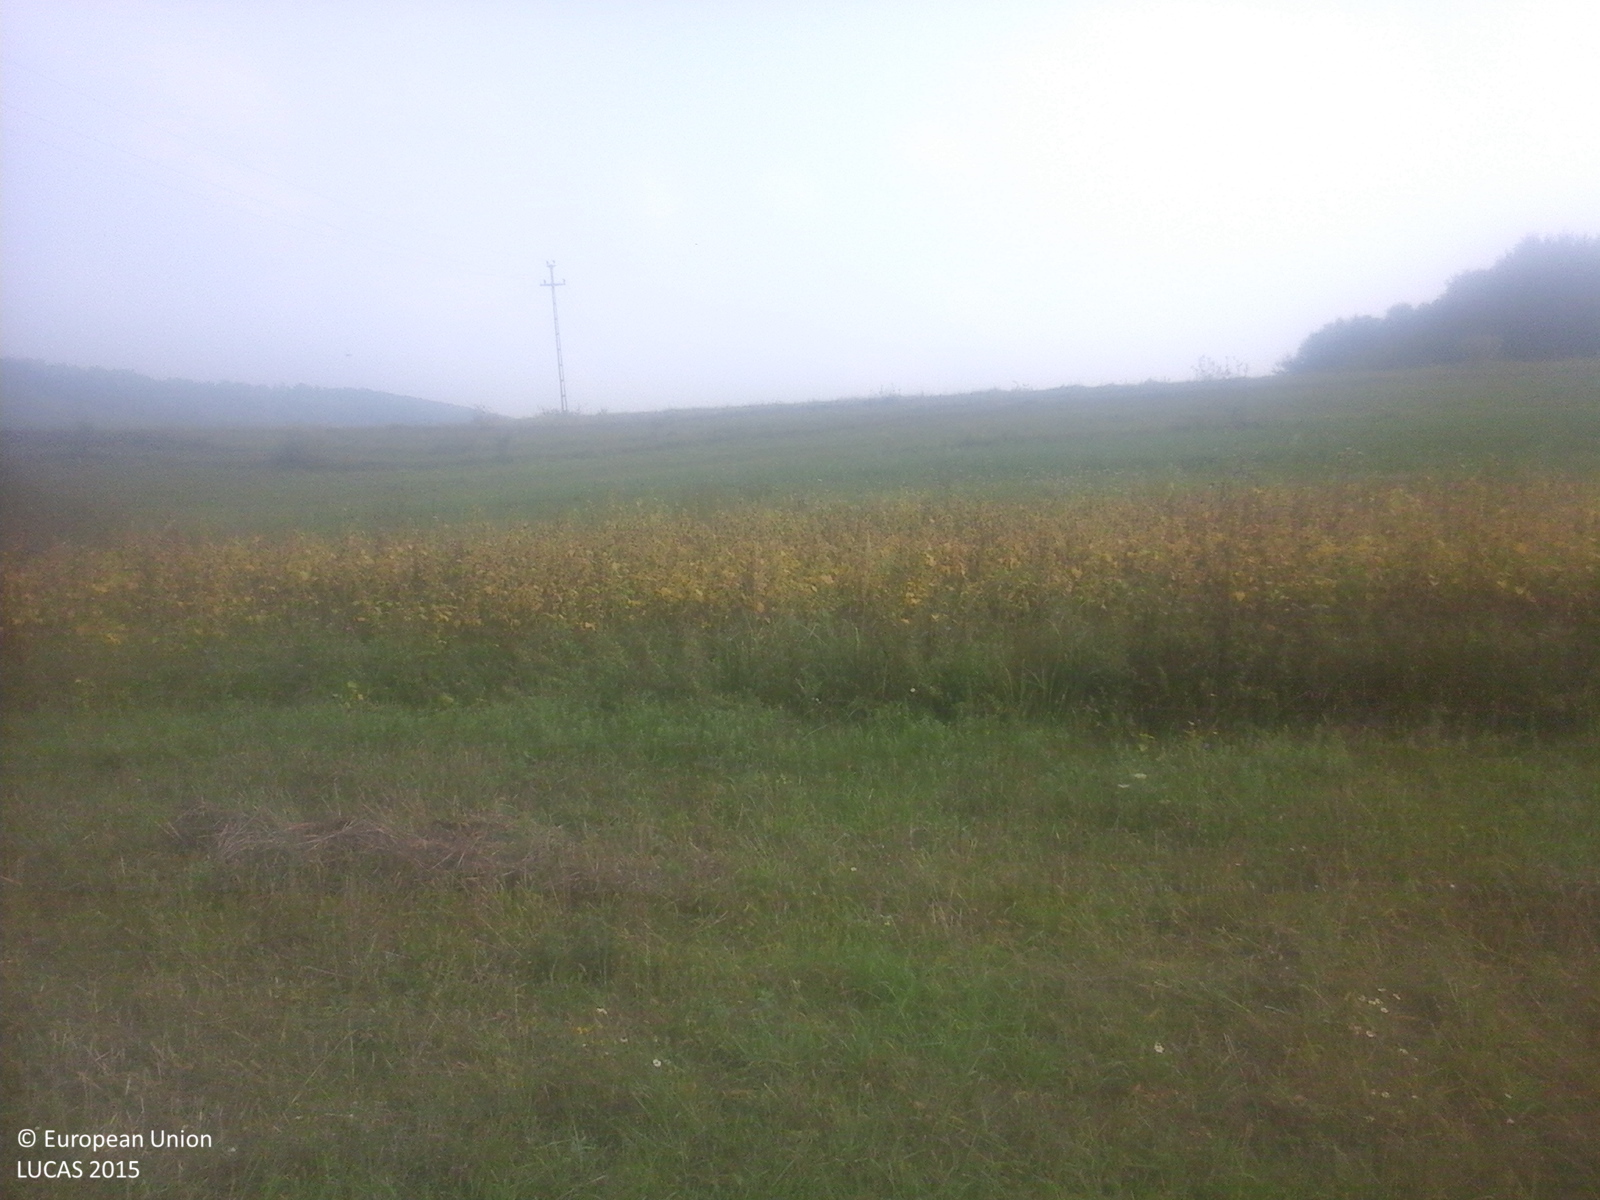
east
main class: Cropland
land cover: Temporary grasslands
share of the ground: > 75 %
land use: Agriculture (excluding fallow land and kitchen gardens)
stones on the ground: < 10 %
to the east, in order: Temporary grasslands; Spontaneously vegetated surfaces; Lucerne; Grassland without tree/shrub cover; Spontaneously vegetated surfaces; Abandoned hedges; Grassland without tree/shrub cover; Abandoned hedges; Grassland without tree/shrub cover; Spontaneously vegetated surfaces; Maize; Electric lines; Maize; Abandoned hedges; Spontaneously vegetated surfaces
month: September
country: RO
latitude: 44.7718
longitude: 23.1276
